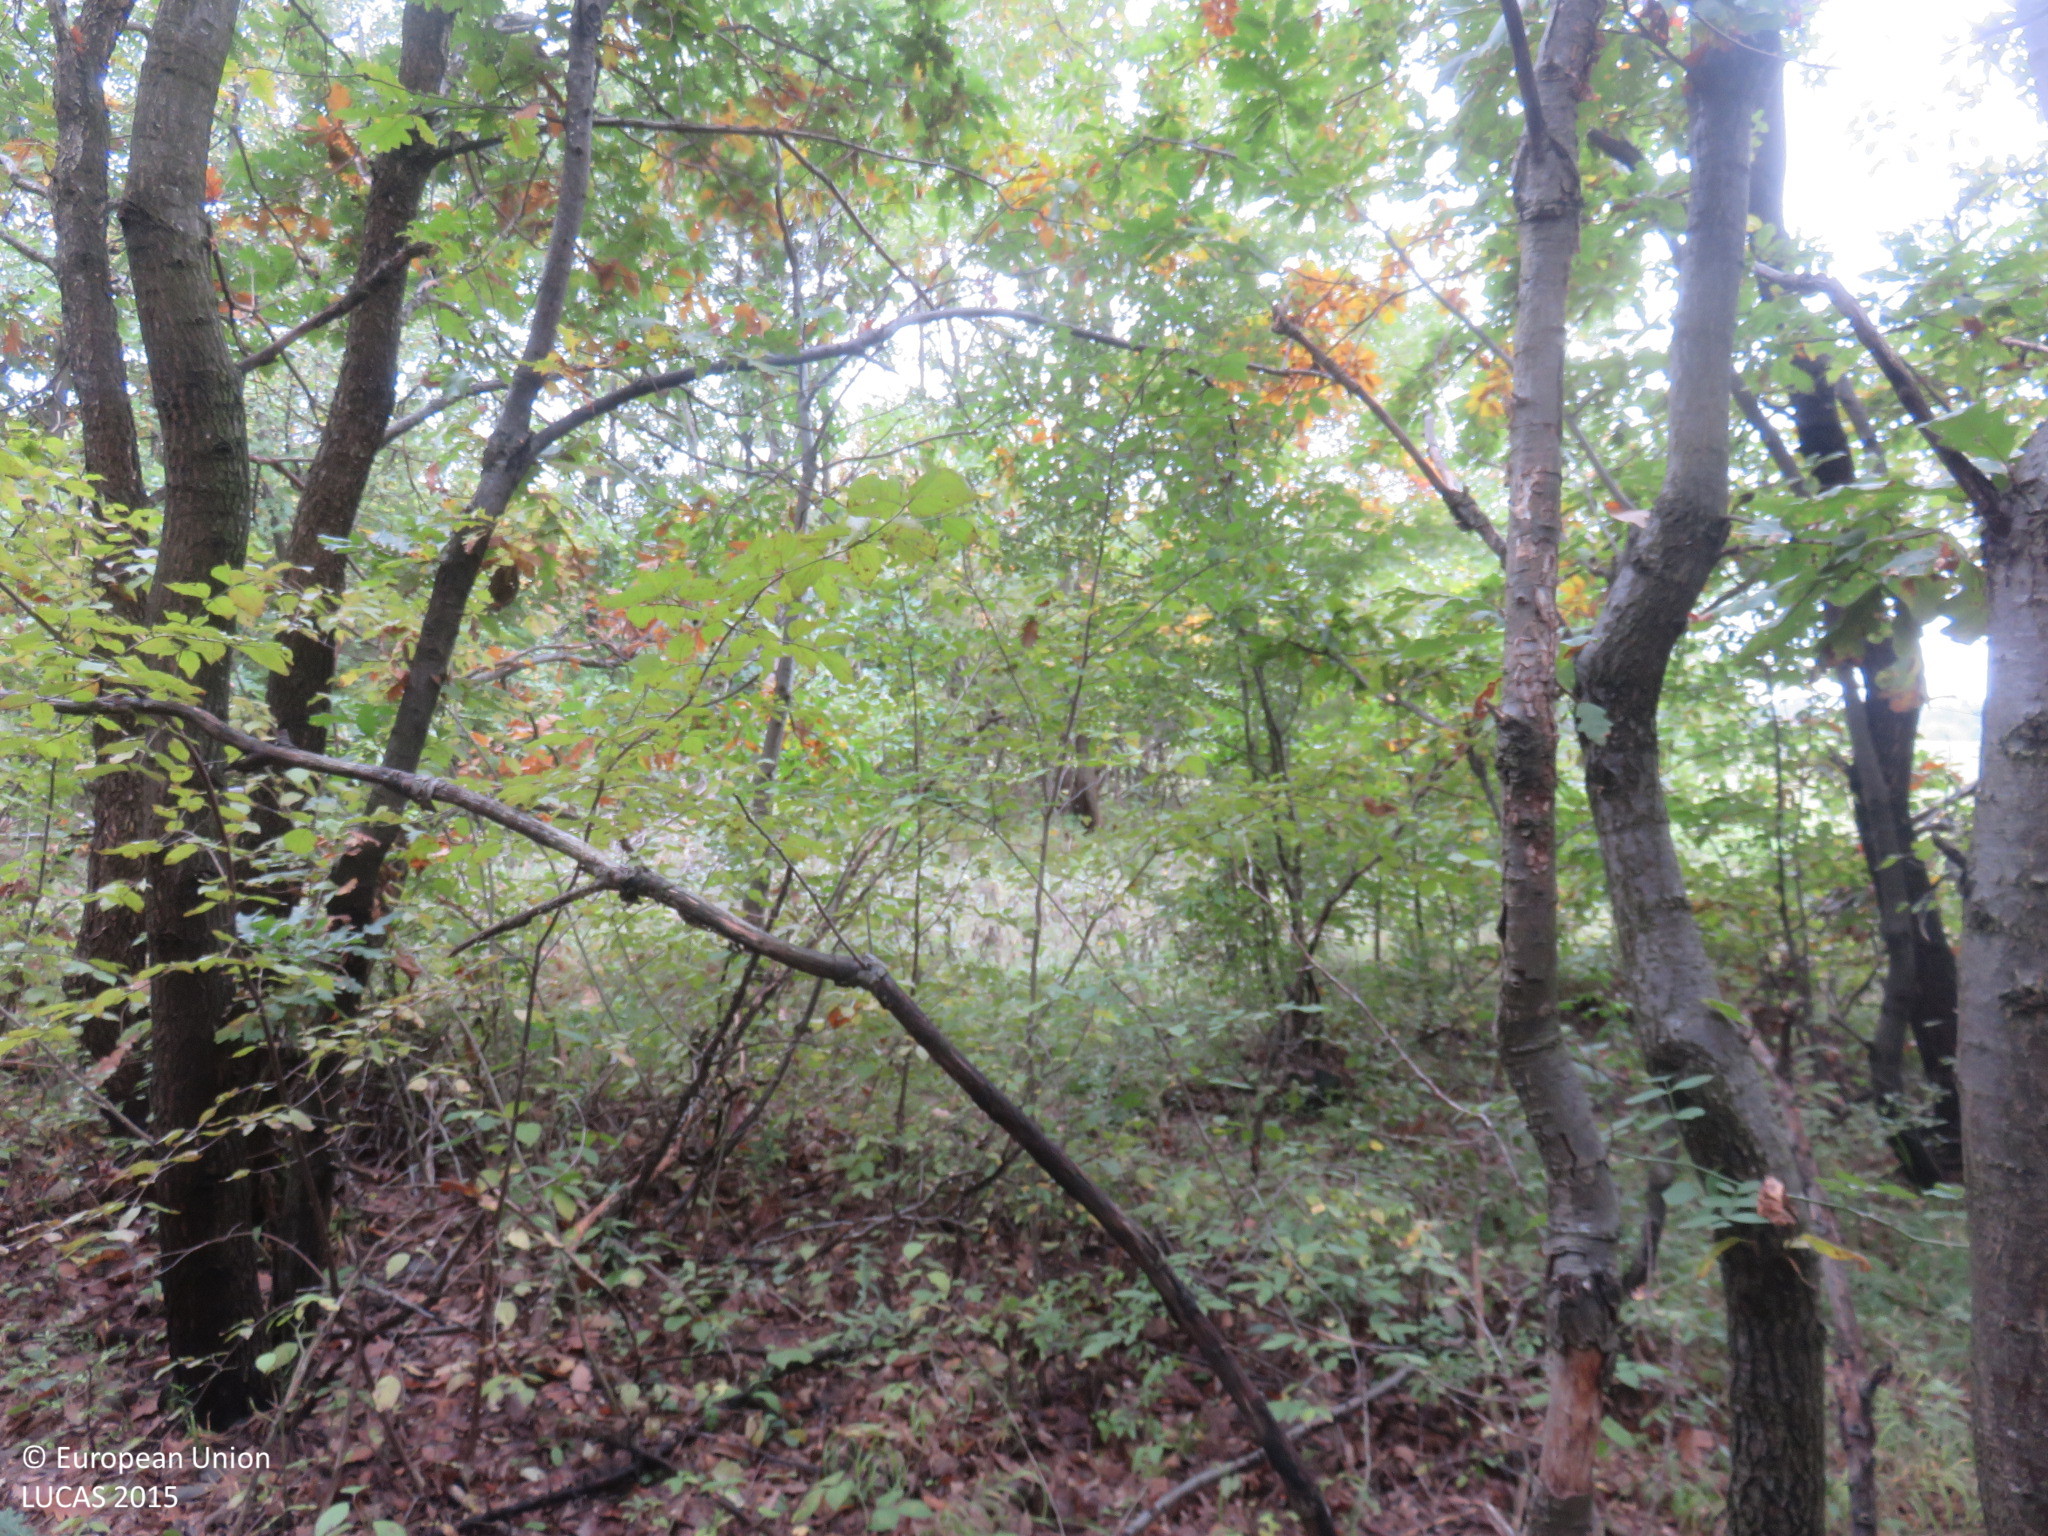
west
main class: Woodland
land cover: Broadleaved woodland
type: mesophytic deciduous forest
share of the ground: > 75 %
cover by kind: broadleaved forest trees 100 %
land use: Forestry
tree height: > 5 m
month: October
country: BG
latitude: 43.0919
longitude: 25.2187
